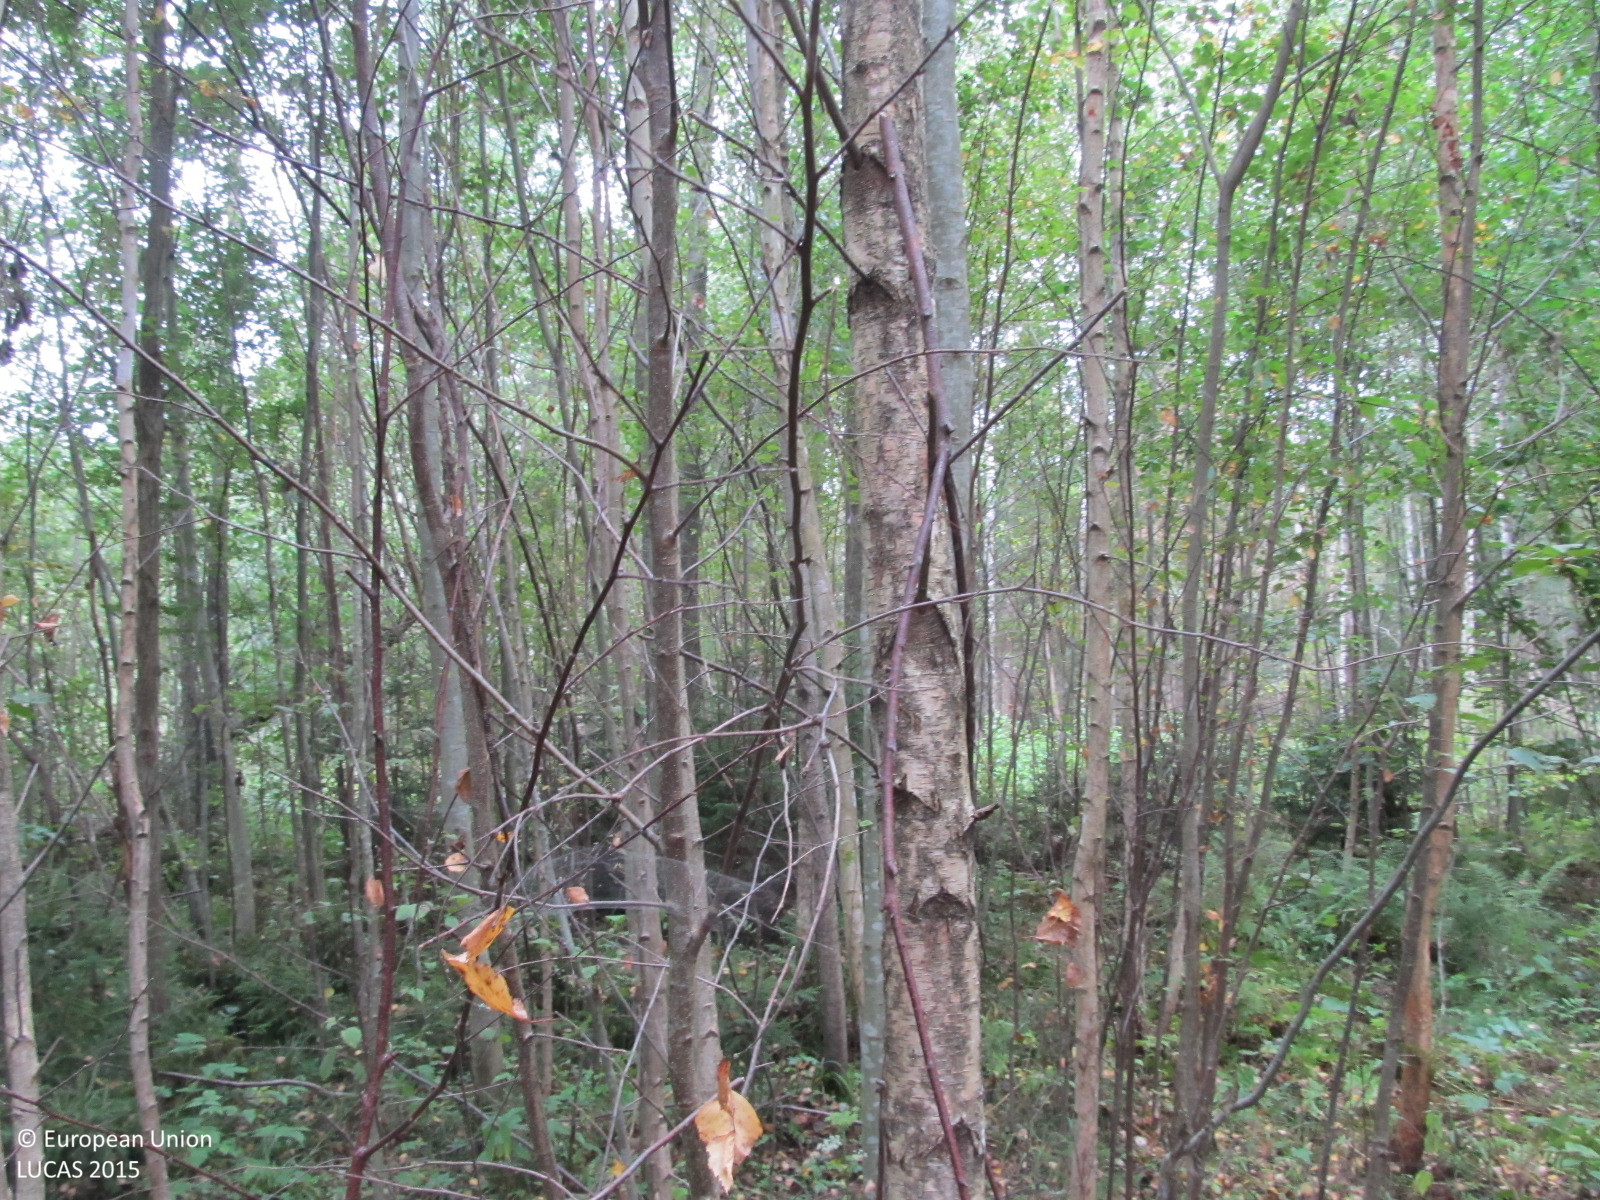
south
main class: Woodland
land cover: Broadleaved woodland
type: non-riverine alder, birch or aspen forest
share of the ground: > 75 %
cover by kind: broadleaved forest trees 70 %, coniferous forest trees 10 %, herbaceous plants 10 %, shrubs 5 %, unconsolidated bare surface 5 %
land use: Forestry
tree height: > 5 m
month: September
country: LT
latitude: 56.0502
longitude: 22.4695
